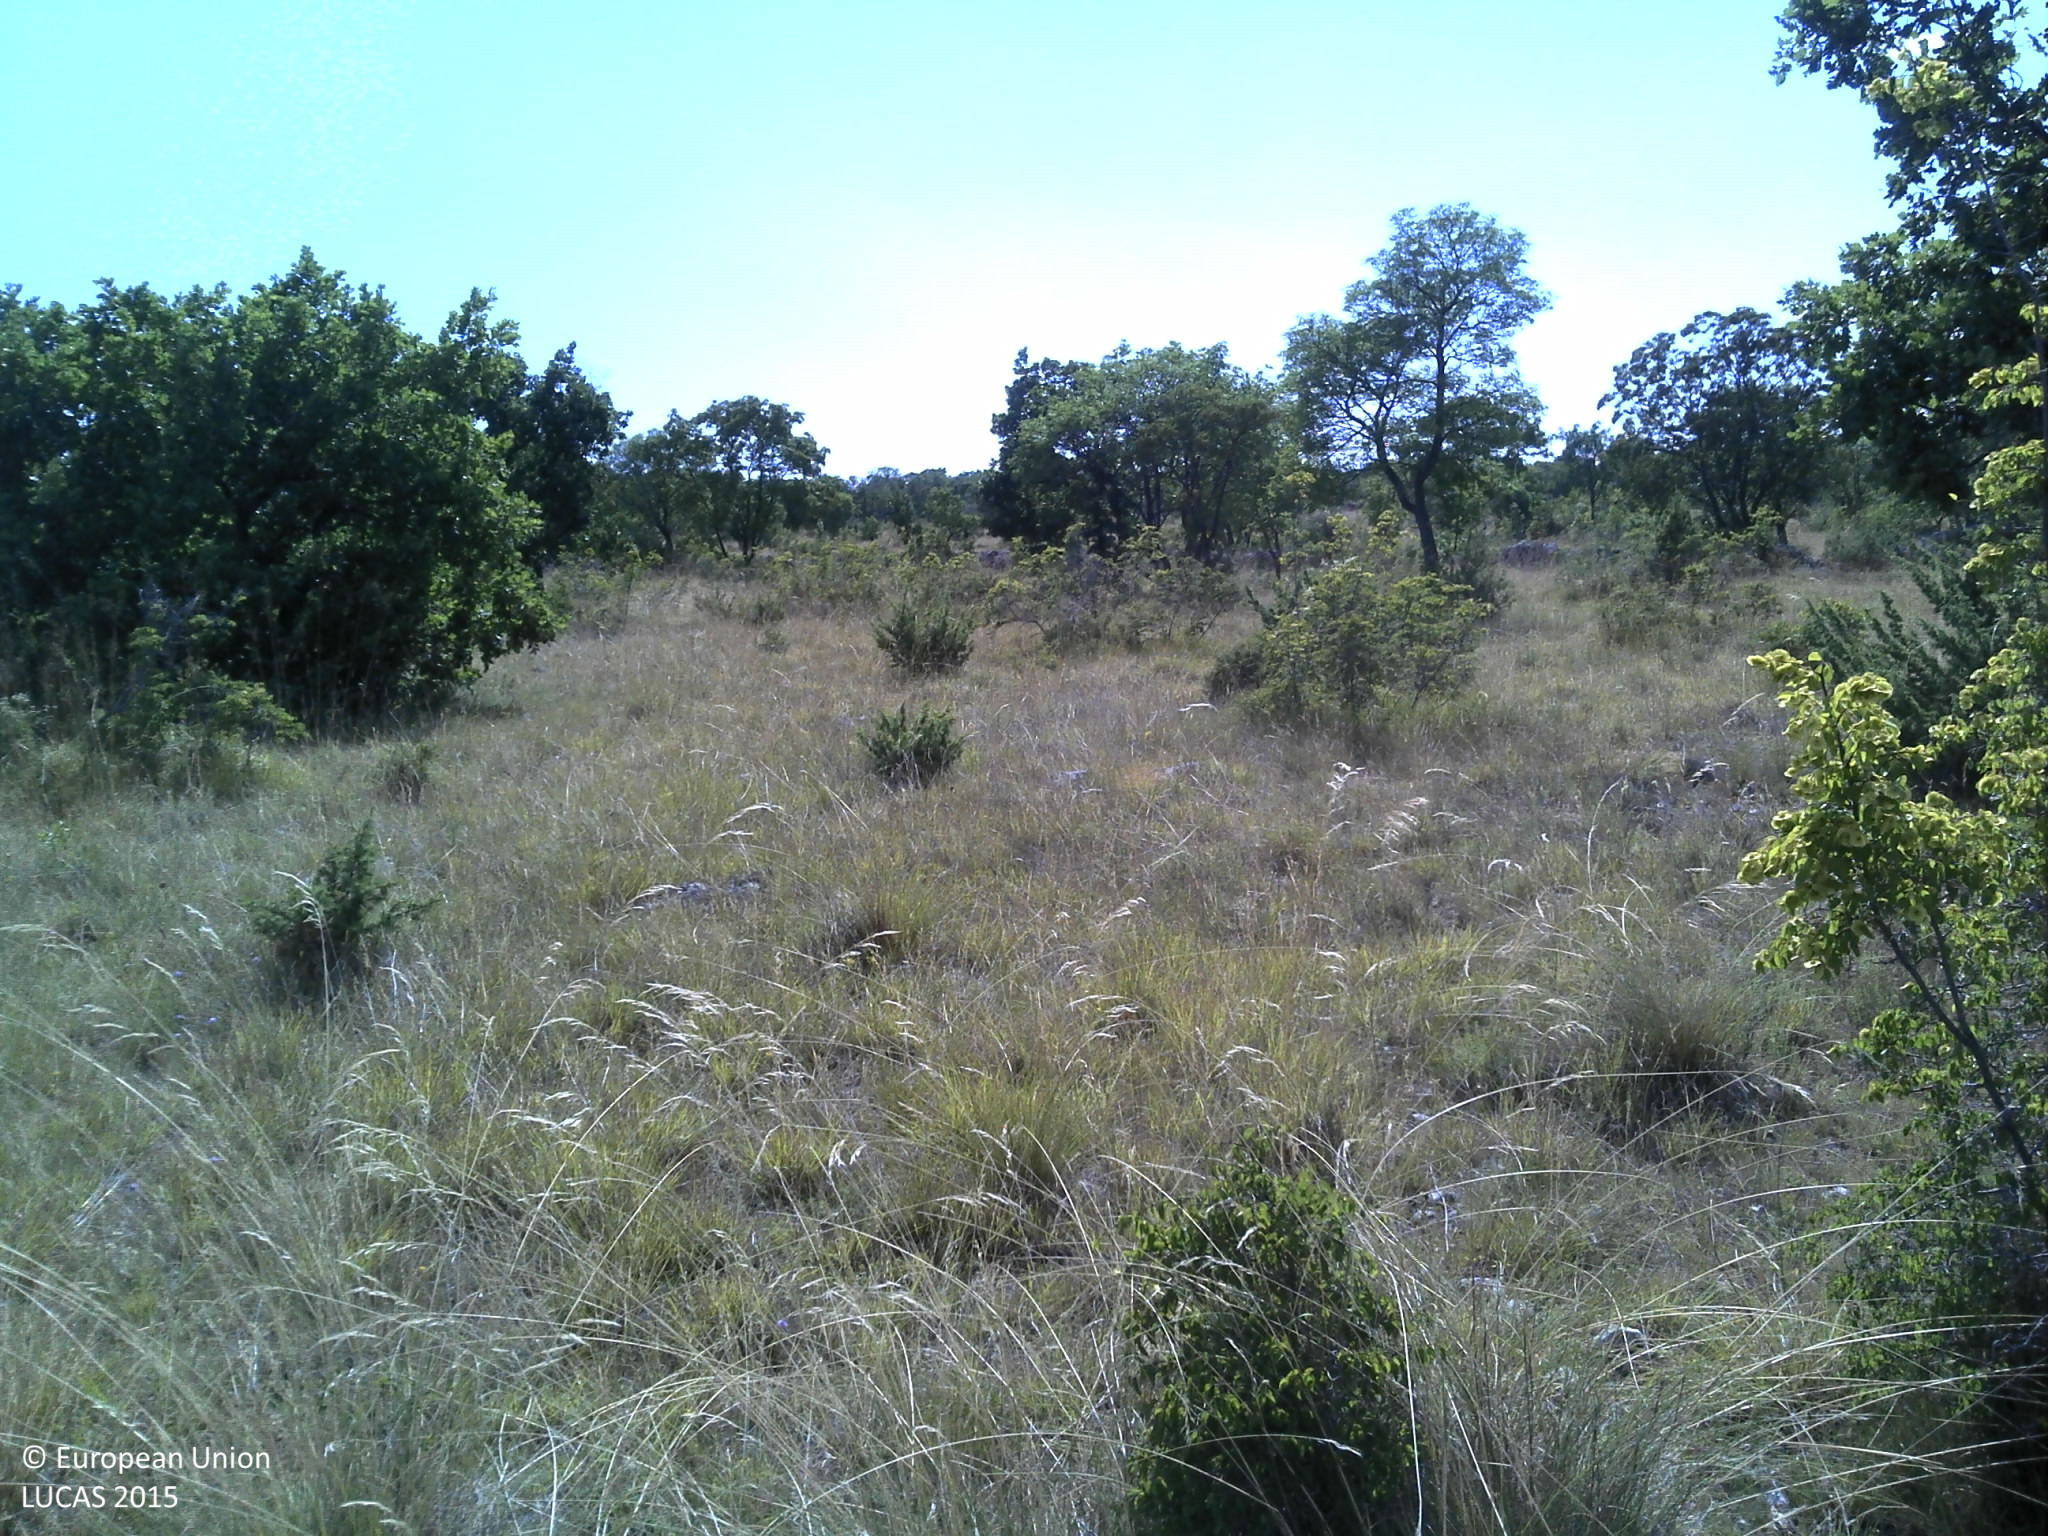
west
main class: Shrubland
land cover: Shrubland with sparse tree cover
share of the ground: 50 - 75 %
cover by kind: shrubs 55 %, herbaceous plants 35 %, broadleaved forest trees 5 %, consolidated bare surface 5 %
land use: Semi-natural and natural areas not in use
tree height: < 5 m
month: July
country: HR
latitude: 44.0073
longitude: 16.1162
